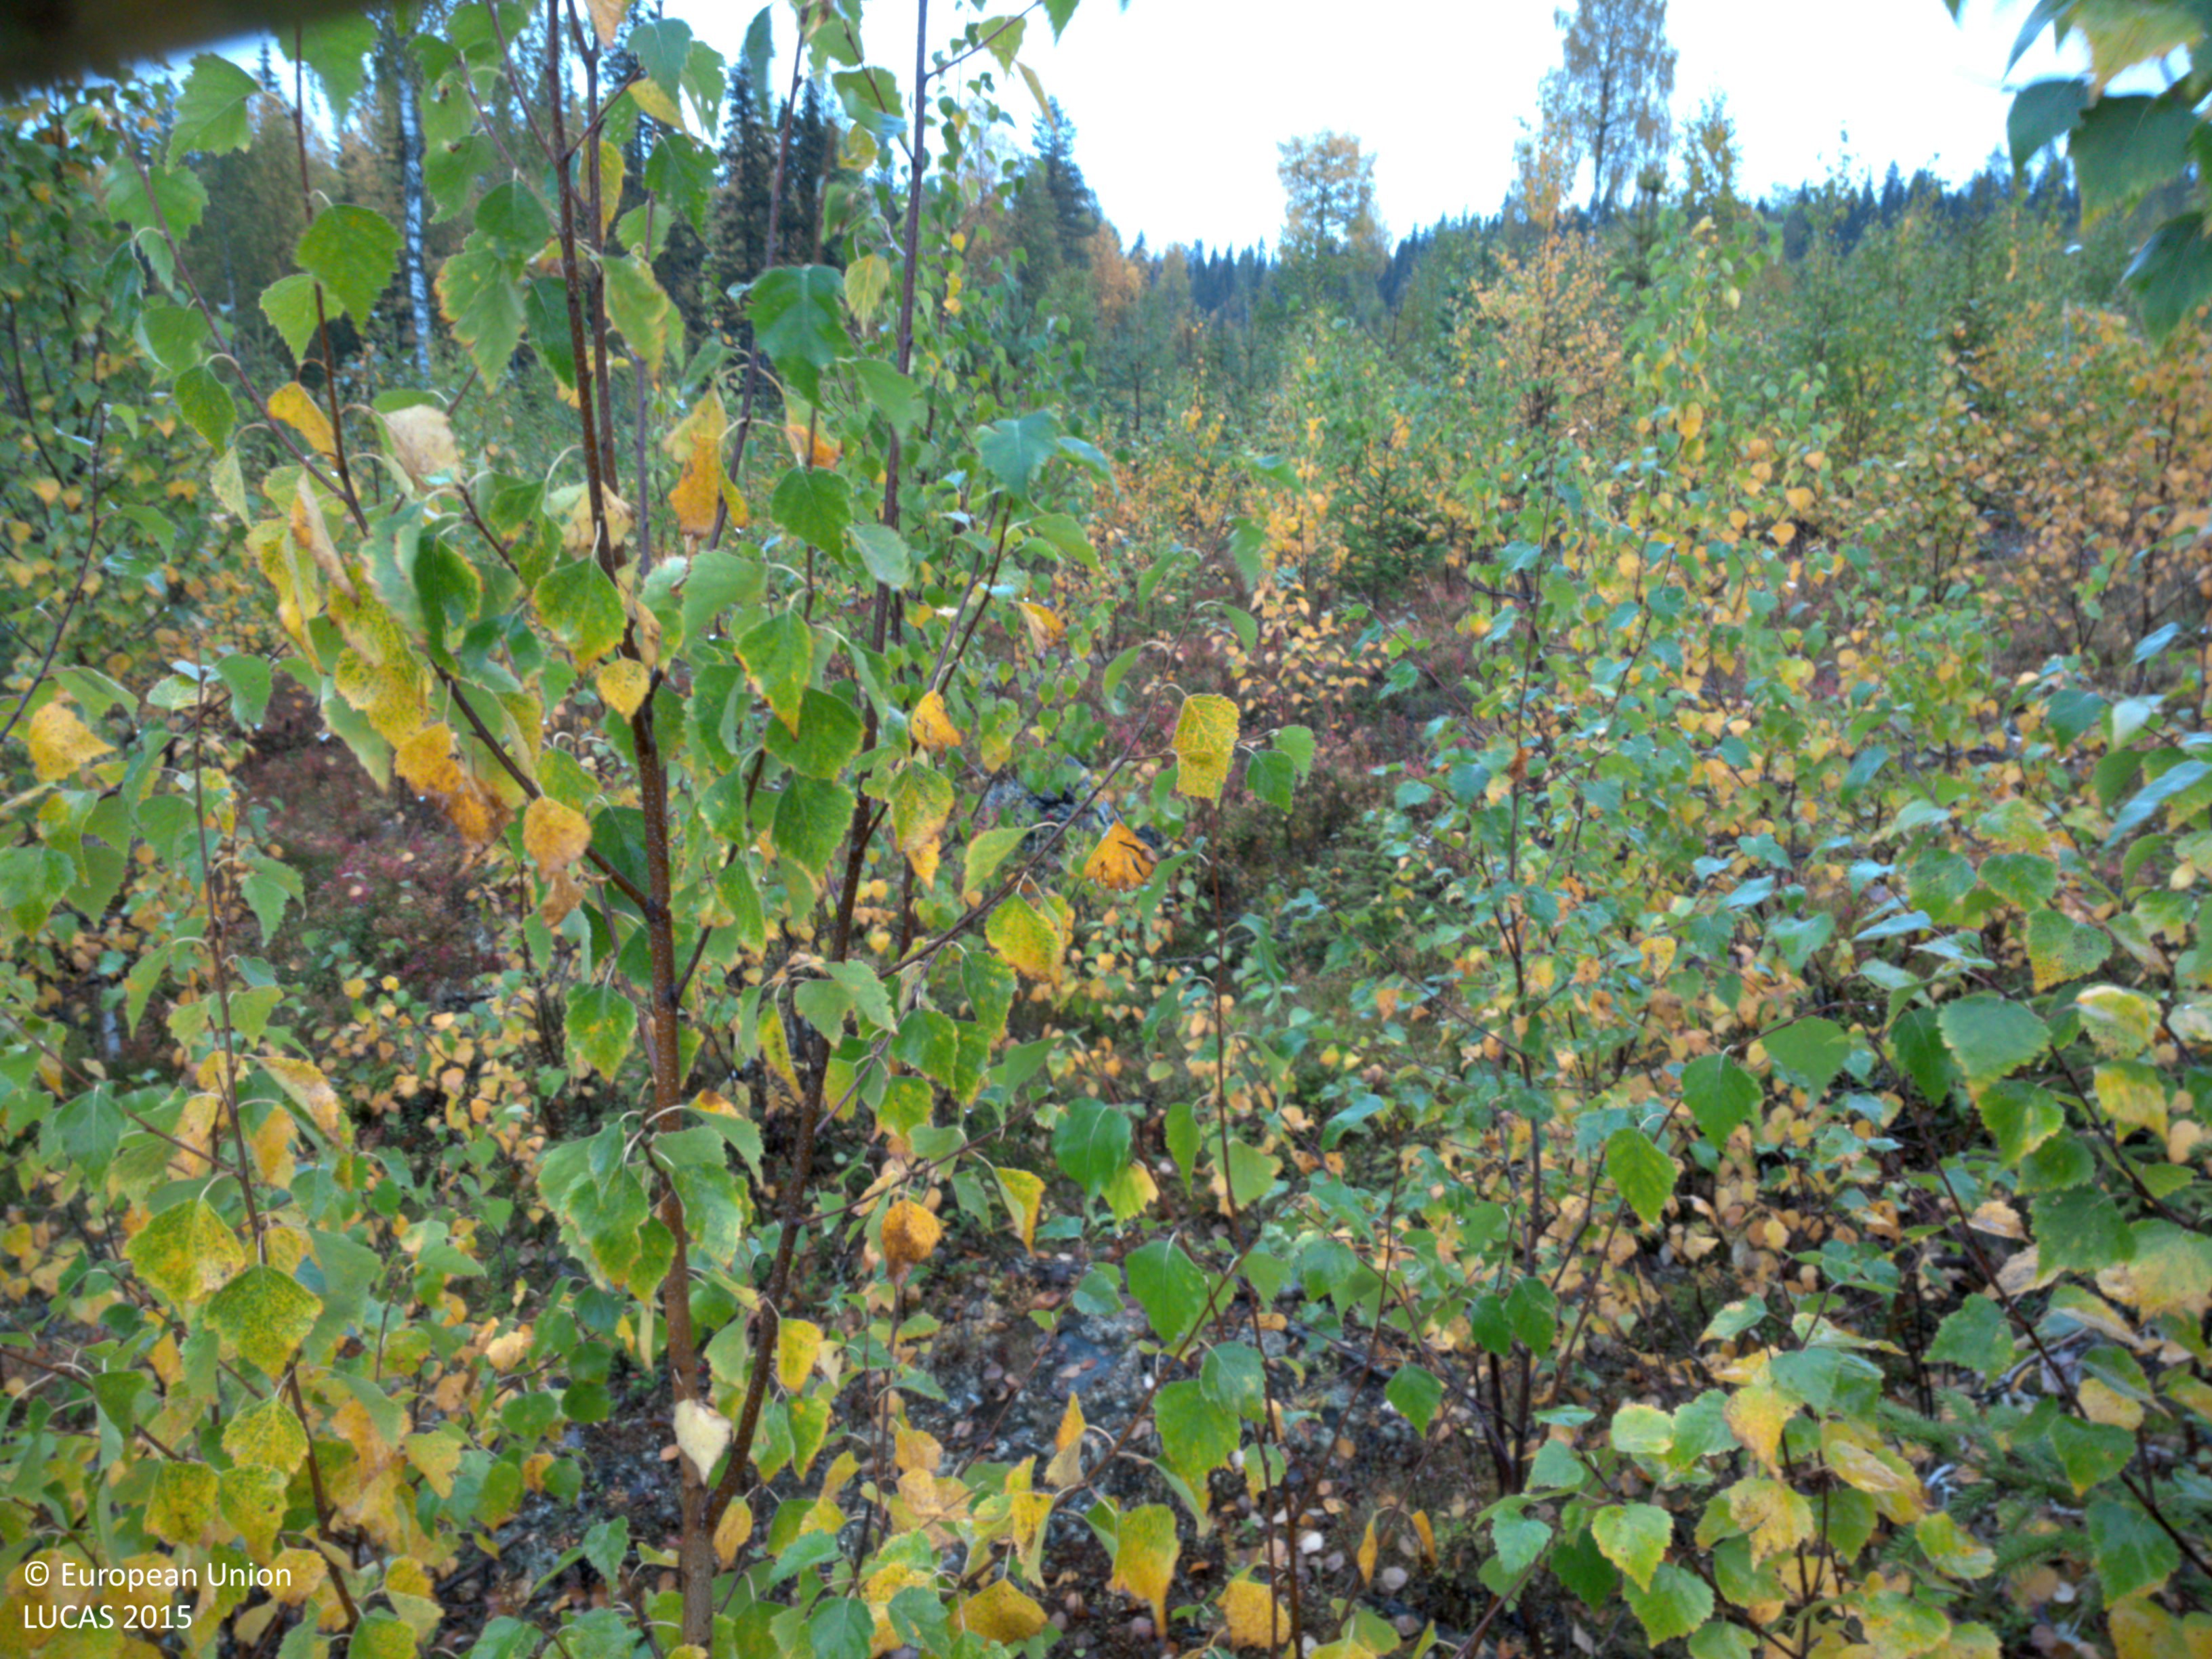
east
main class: Woodland
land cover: Spruce dominated mixed woodland
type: boreal forest
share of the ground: 50 - 75 %
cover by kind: coniferous forest trees 40 %, broadleaved forest trees 30 %, shrubs 25 %, herbaceous plants 5 %
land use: Forestry
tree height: < 5 m
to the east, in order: Spruce dominated mixed woodland; Pine dominated mixed woodland; Spruce dominated mixed woodland; Temporary grasslands; Spruce dominated mixed woodland
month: September
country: SE
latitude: 64.9134
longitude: 19.2042
